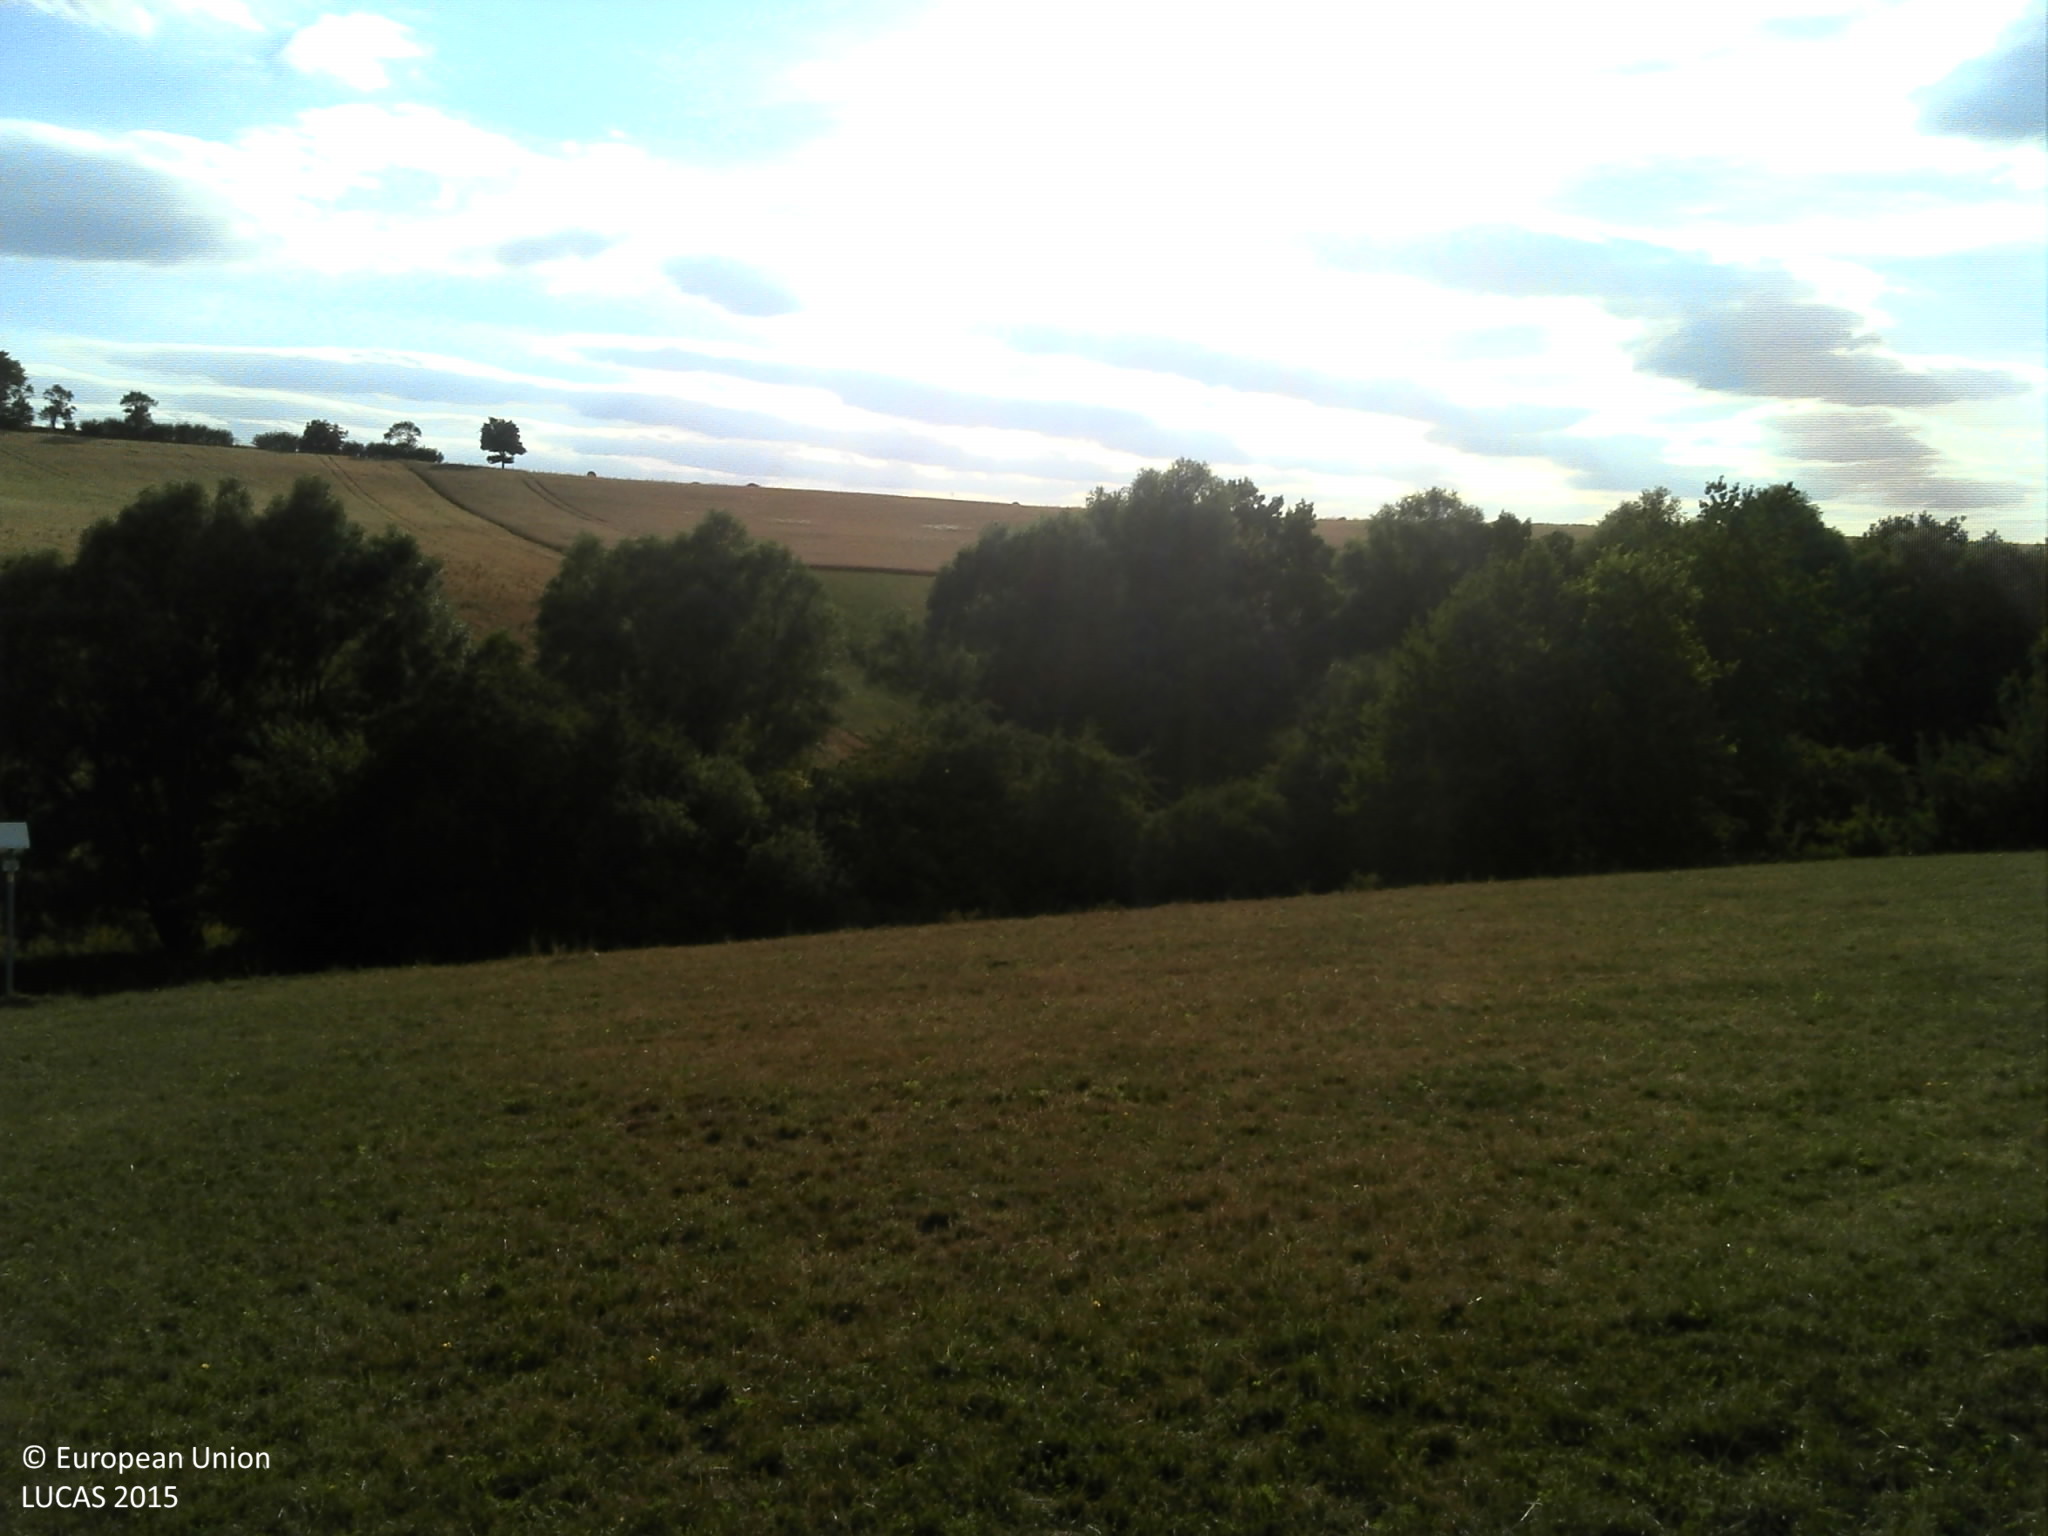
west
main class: Grassland
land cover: Grassland without tree/shrub cover
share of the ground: > 75 %
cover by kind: herbaceous plants 100 %
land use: Agriculture (excluding fallow land and kitchen gardens)
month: July
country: FR
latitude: 49.1099
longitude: 7.3566
